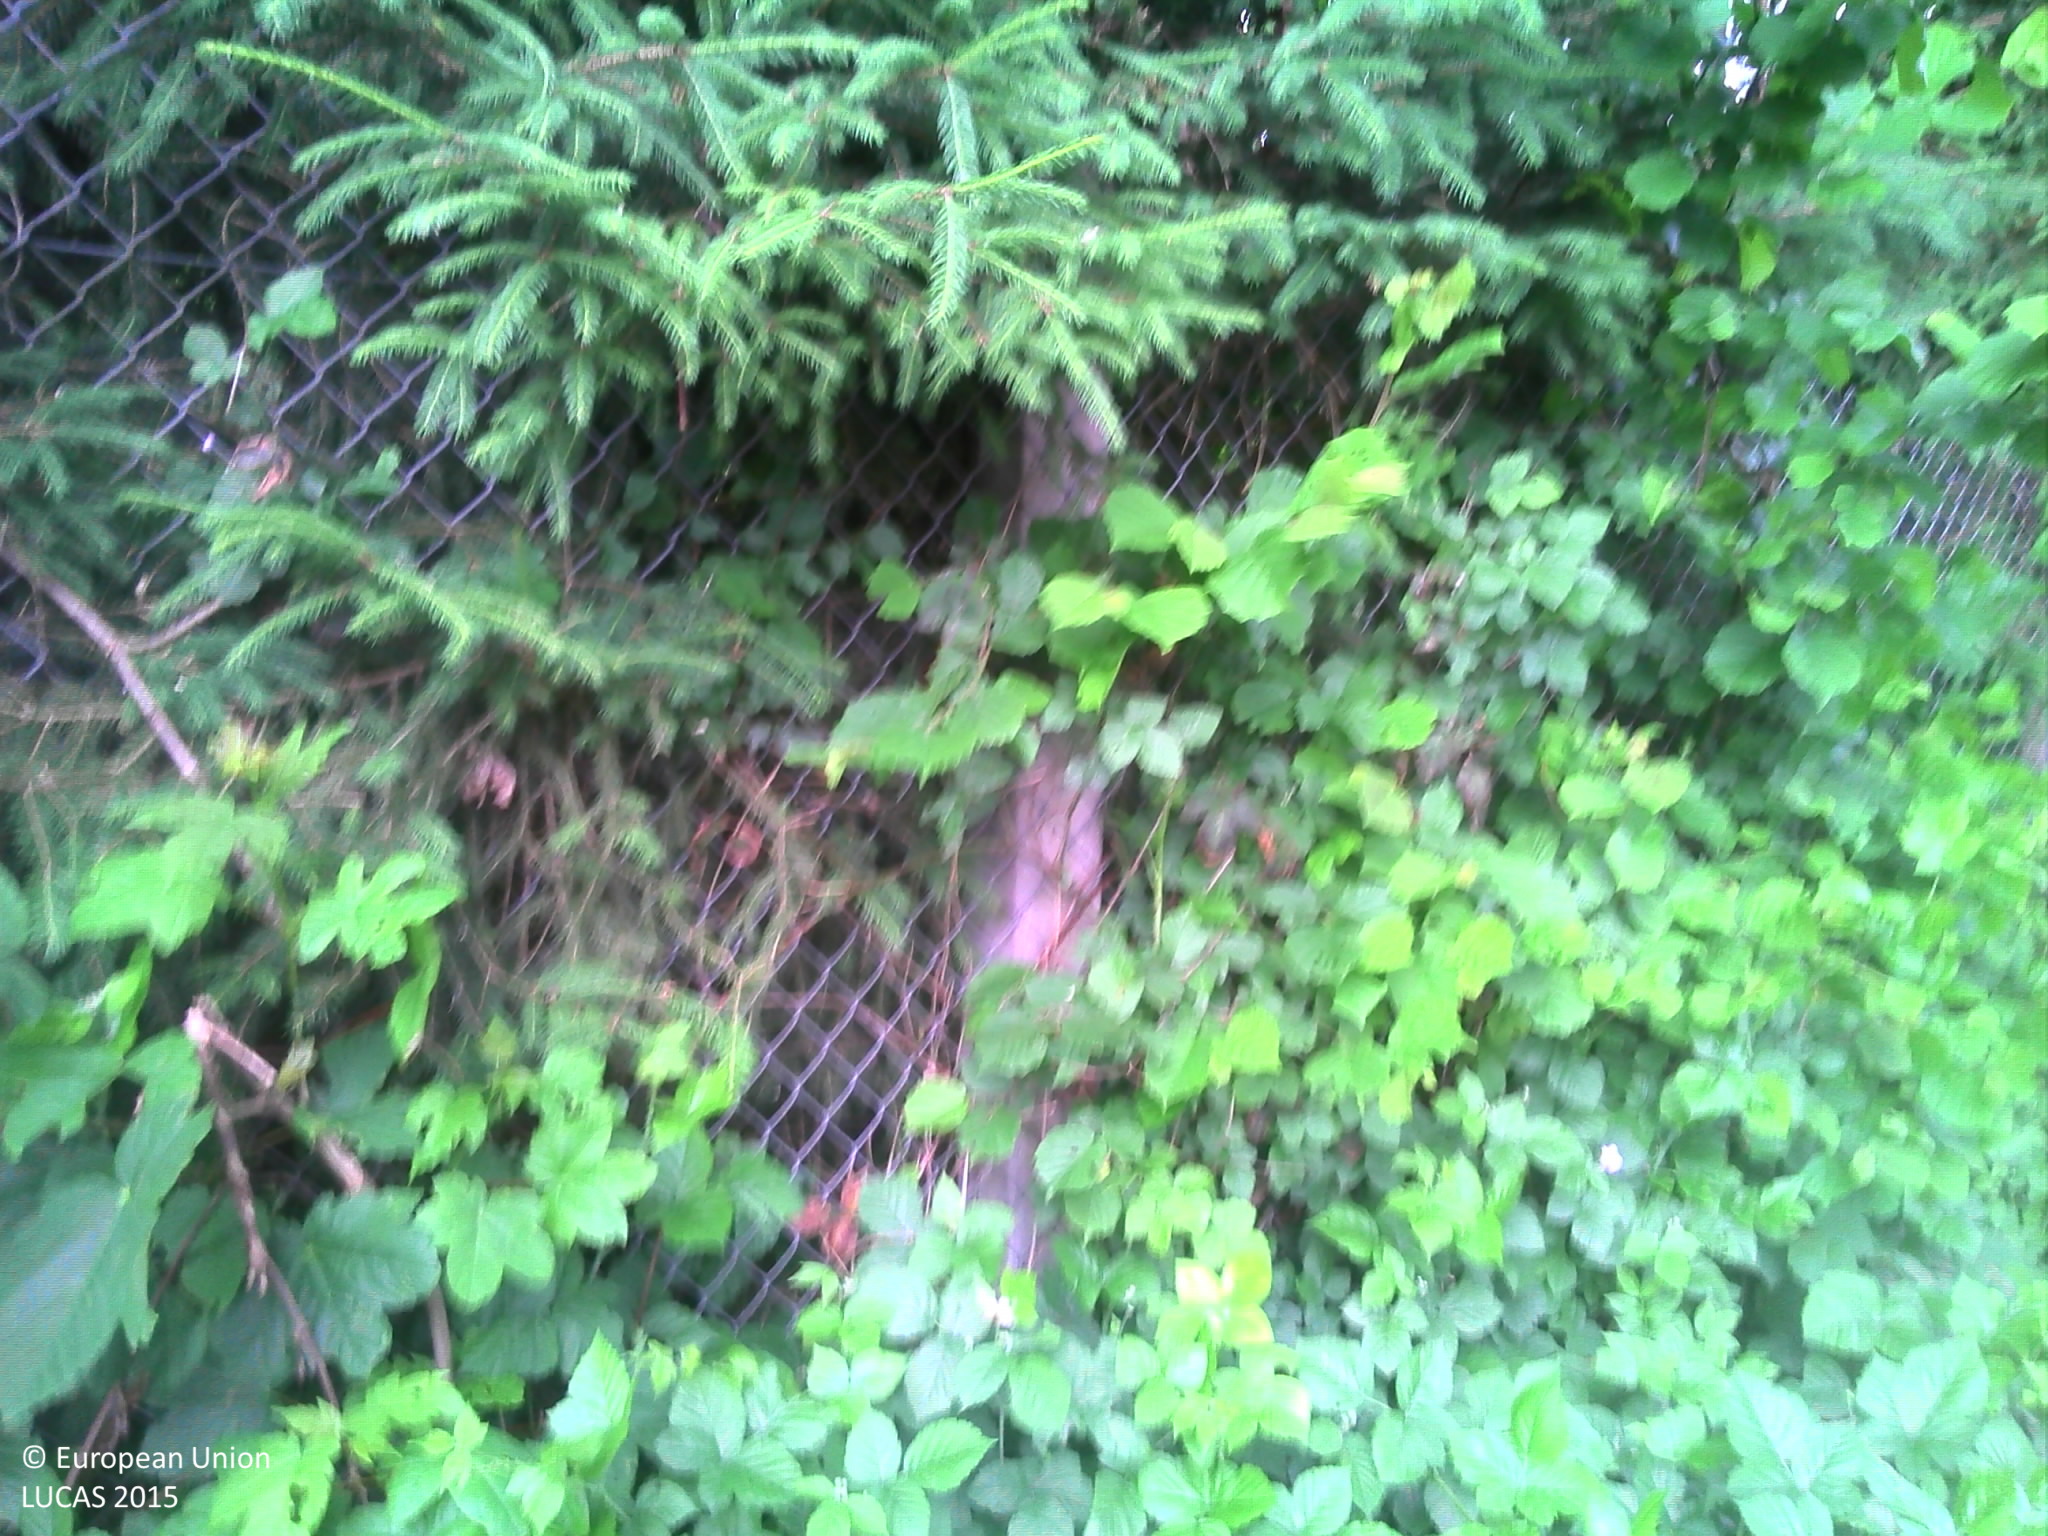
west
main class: Woodland
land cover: Broadleaved woodland
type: beech forest
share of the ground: > 75 %
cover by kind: broadleaved forest trees 95 %, coniferous forest trees 5 %
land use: Forestry
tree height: > 5 m
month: May
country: FR
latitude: 48.3237
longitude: 7.6138
